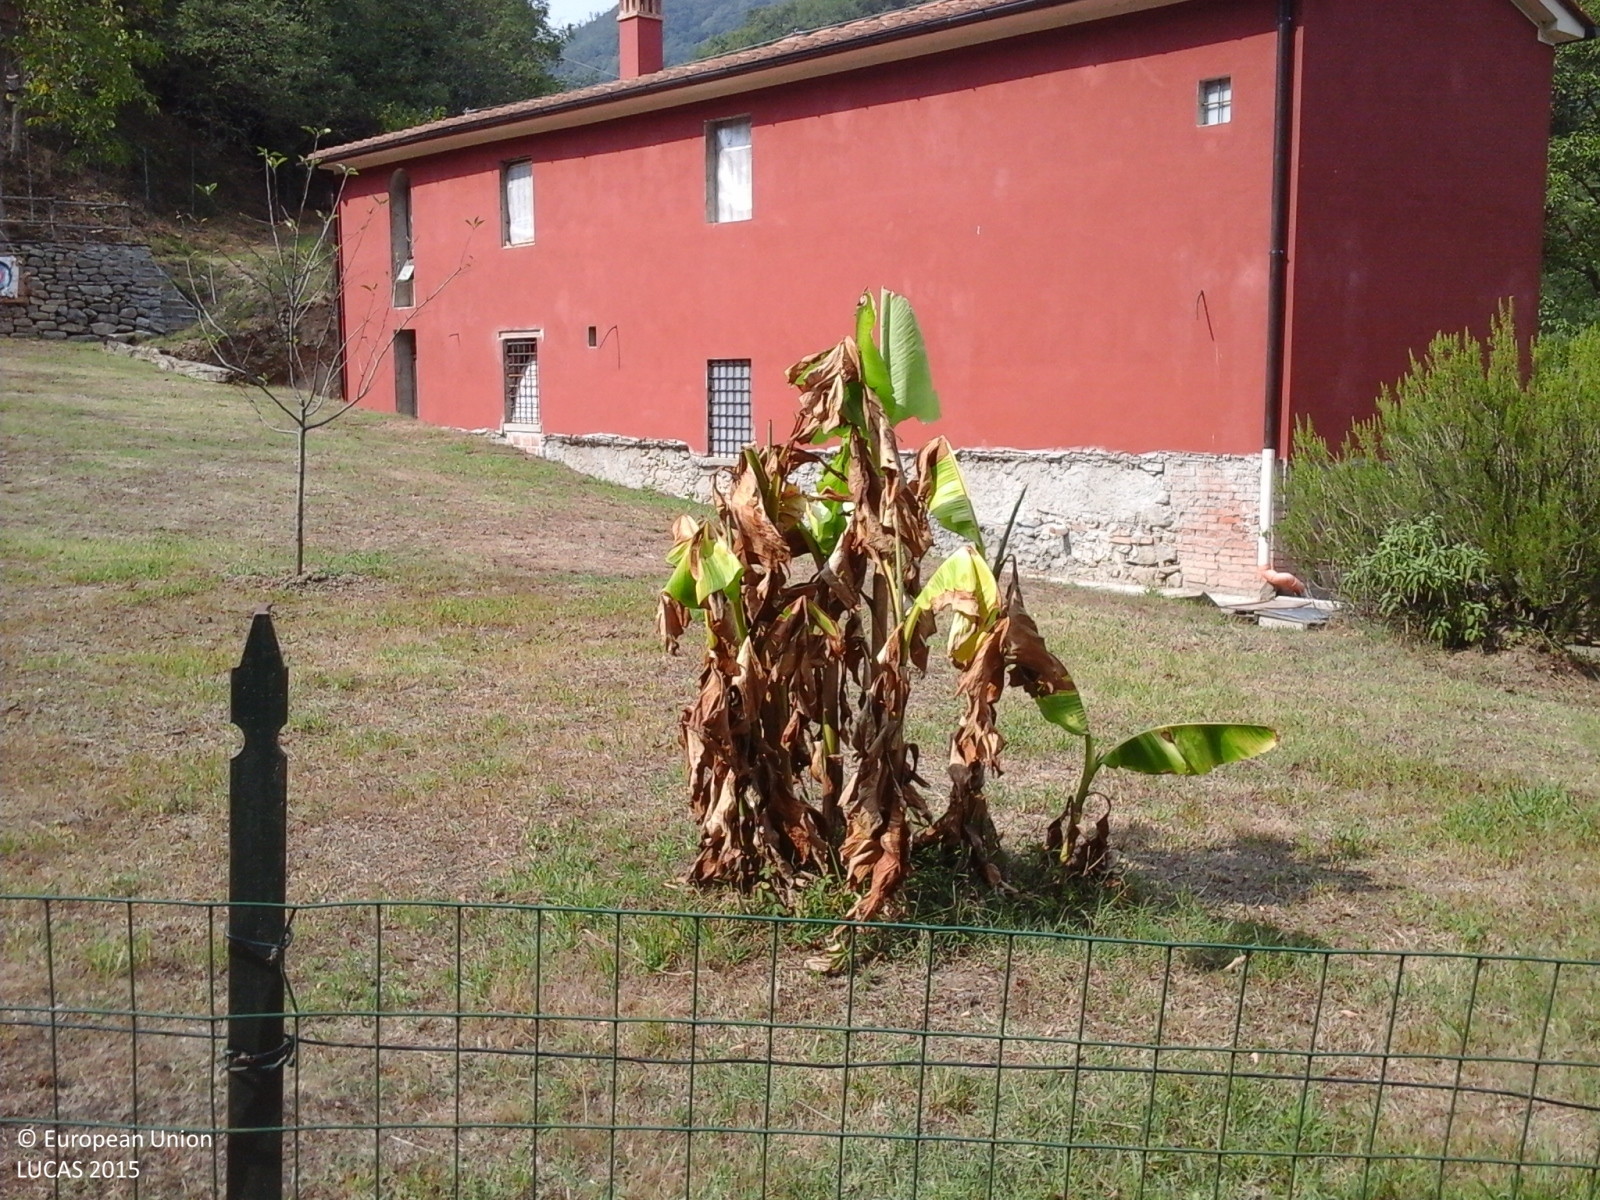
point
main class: Grassland
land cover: Grassland without tree/shrub cover
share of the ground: 50 - 75 %
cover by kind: herbaceous plants 95 %, shrubs 5 %
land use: Residential
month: August
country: IT
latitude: 43.9501
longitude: 10.8576
